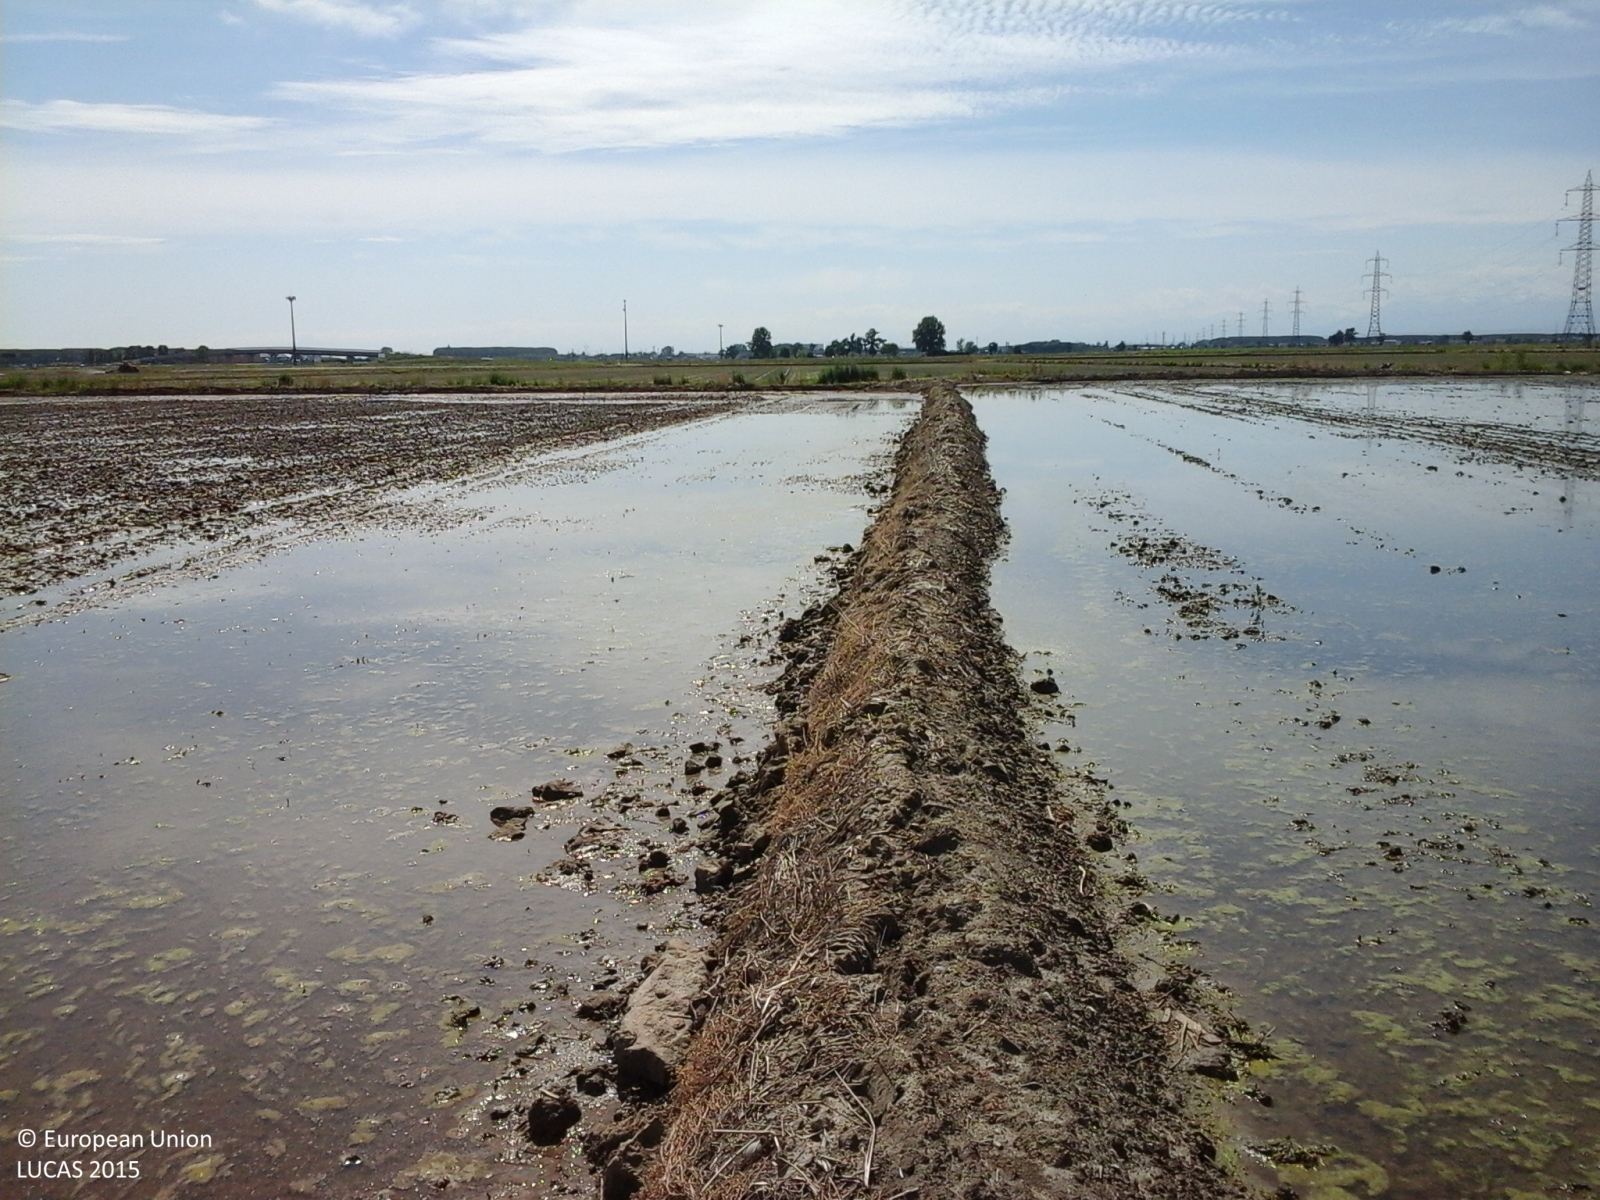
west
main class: Cropland
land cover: Rice
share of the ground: < 10 %
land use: Agriculture (excluding fallow land and kitchen gardens)
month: May
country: IT
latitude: 45.4758
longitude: 8.5058
